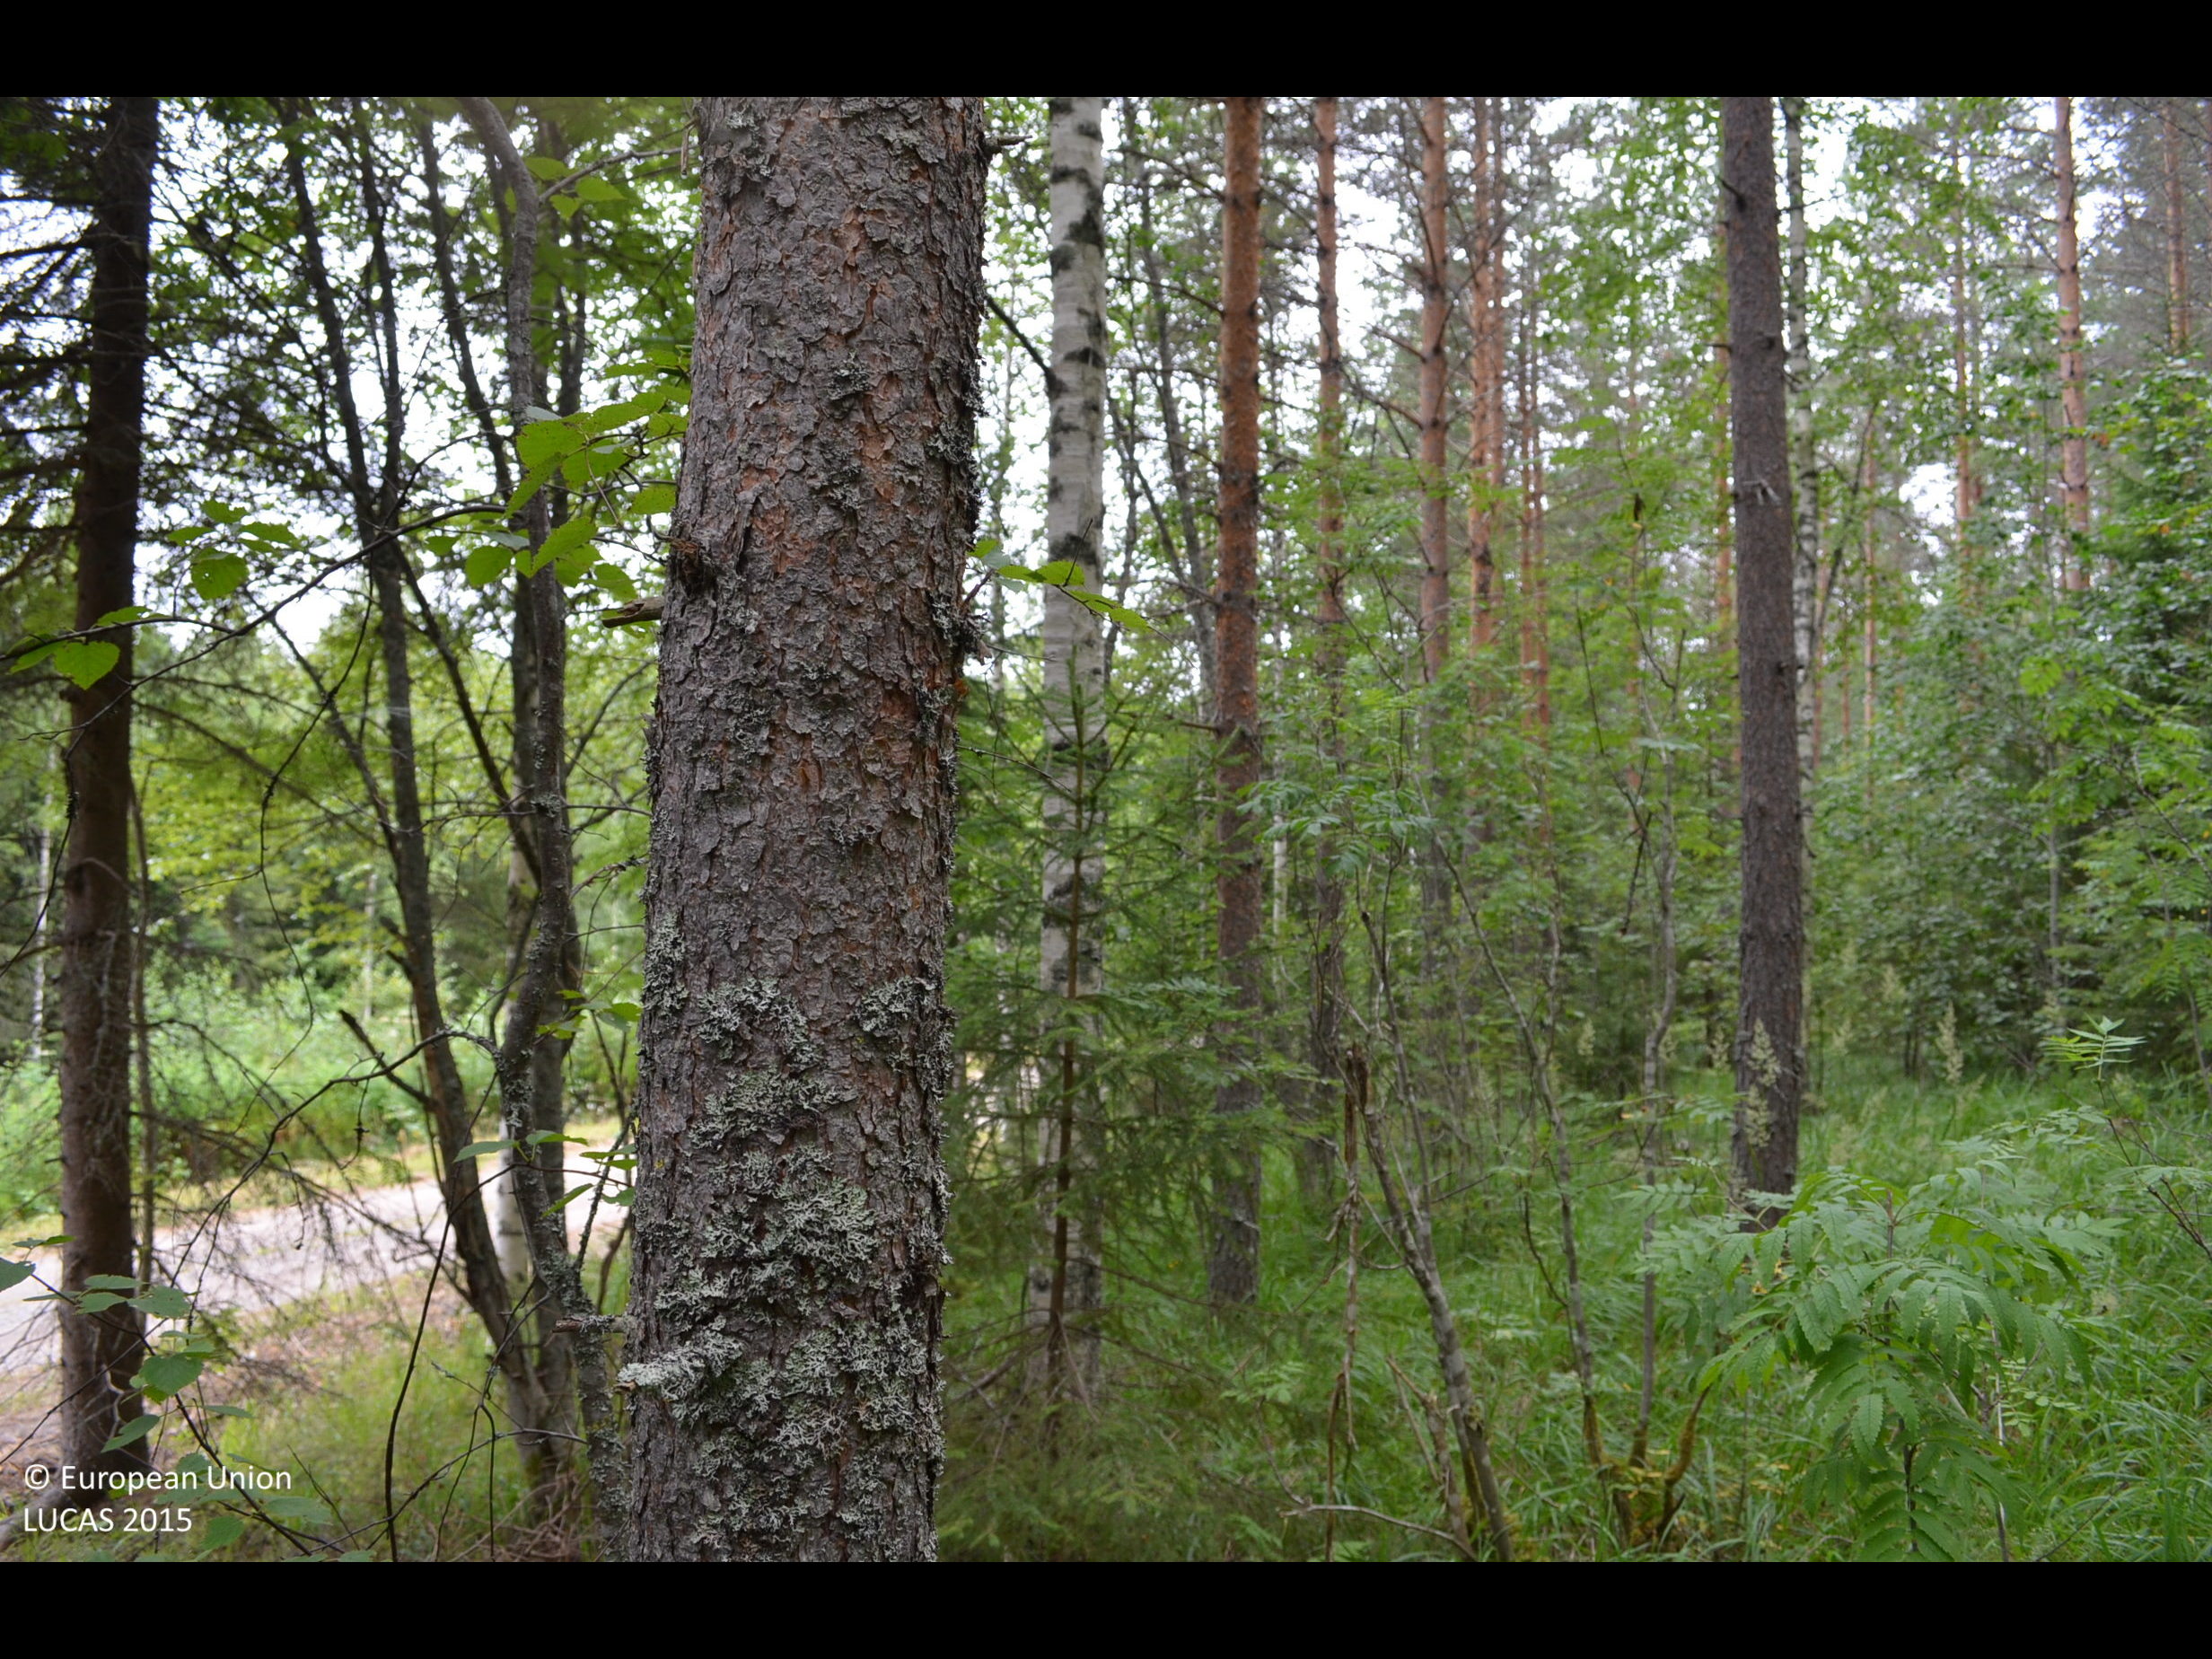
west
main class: Woodland
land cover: Other mixed woodland
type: boreal forest
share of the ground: > 75 %
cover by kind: broadleaved forest trees 45 %, coniferous forest trees 35 %, shrubs 20 %
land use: Forestry
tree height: > 5 m
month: August
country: FI
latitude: 62.1801
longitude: 24.3216
